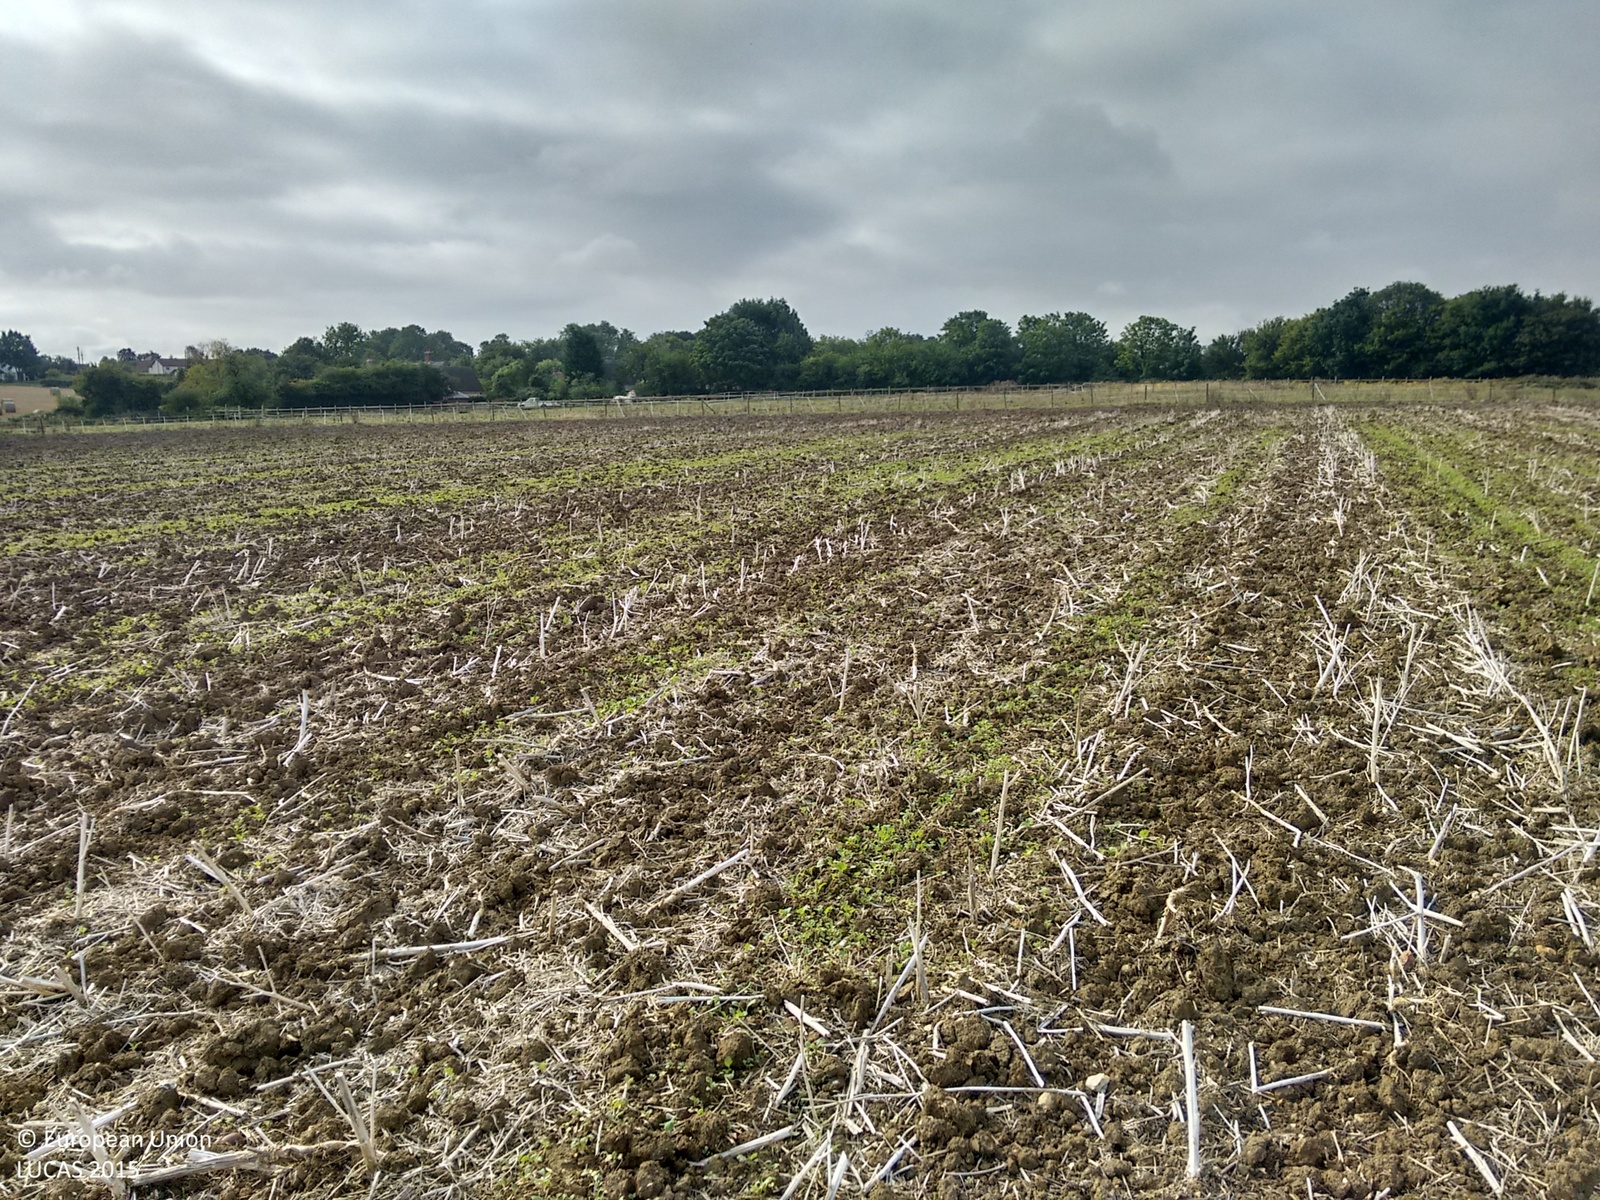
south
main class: Cropland
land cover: Rape and turnip rape
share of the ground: 25 - 50 %
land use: Agriculture (excluding fallow land and kitchen gardens)
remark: Harvested field
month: September
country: GB
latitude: 52.1607
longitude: 0.9864
